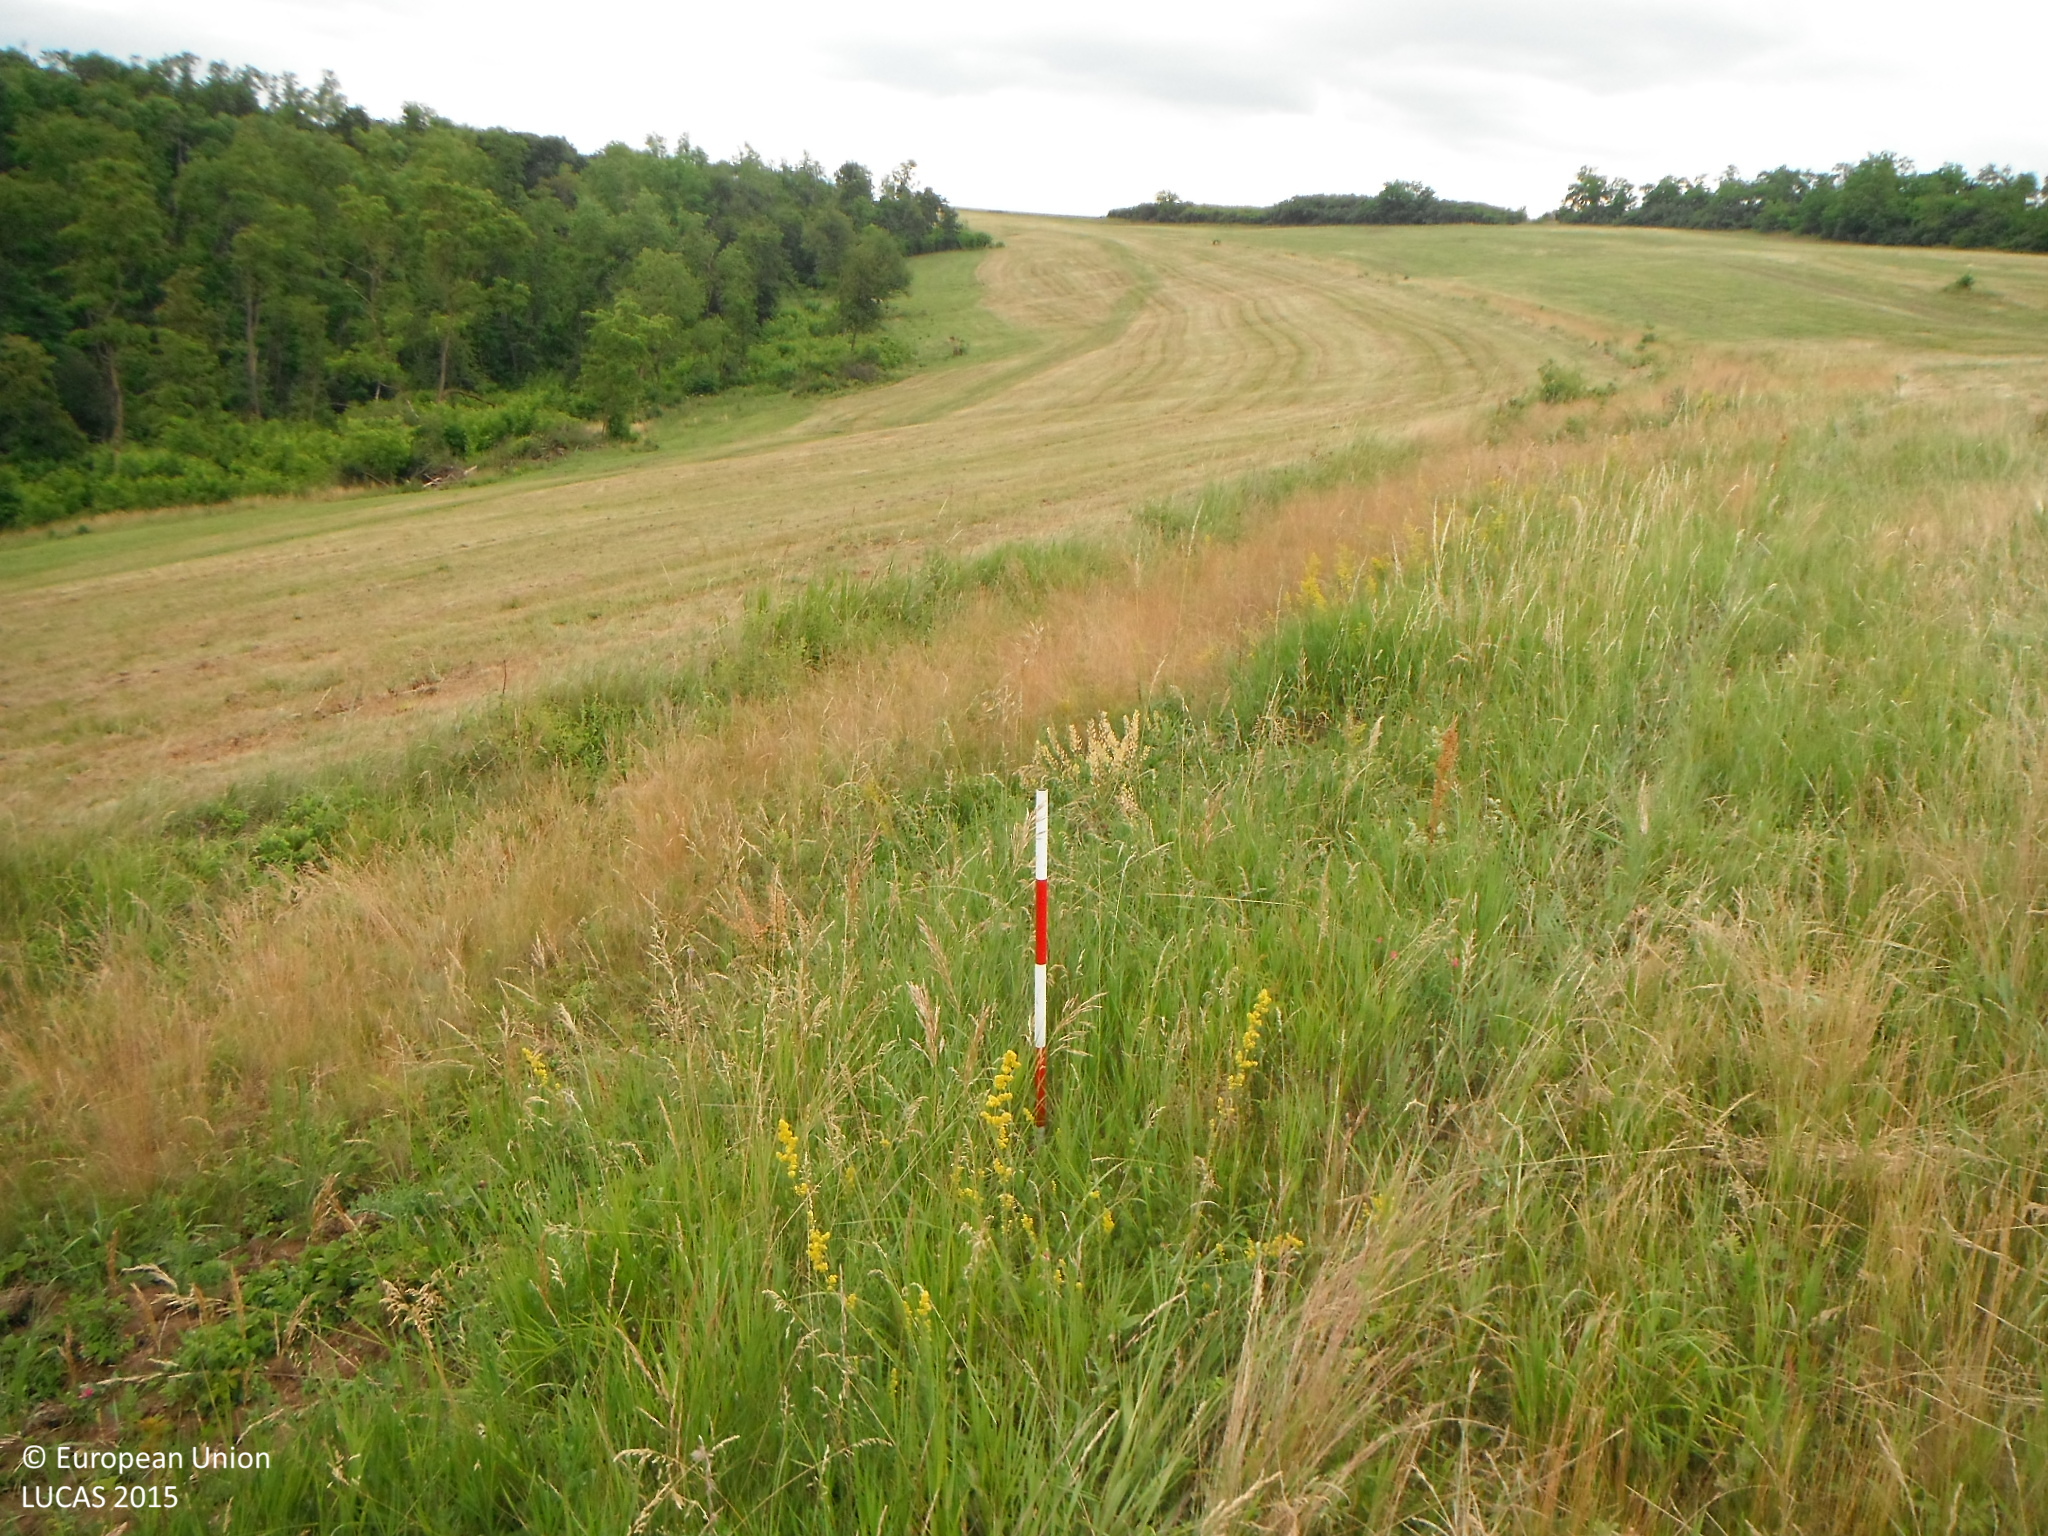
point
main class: Grassland
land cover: Grassland without tree/shrub cover
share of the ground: > 75 %
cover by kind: herbaceous plants 100 %
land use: Agriculture (excluding fallow land and kitchen gardens)
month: June
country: SK
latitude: 48.1701
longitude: 18.9073
